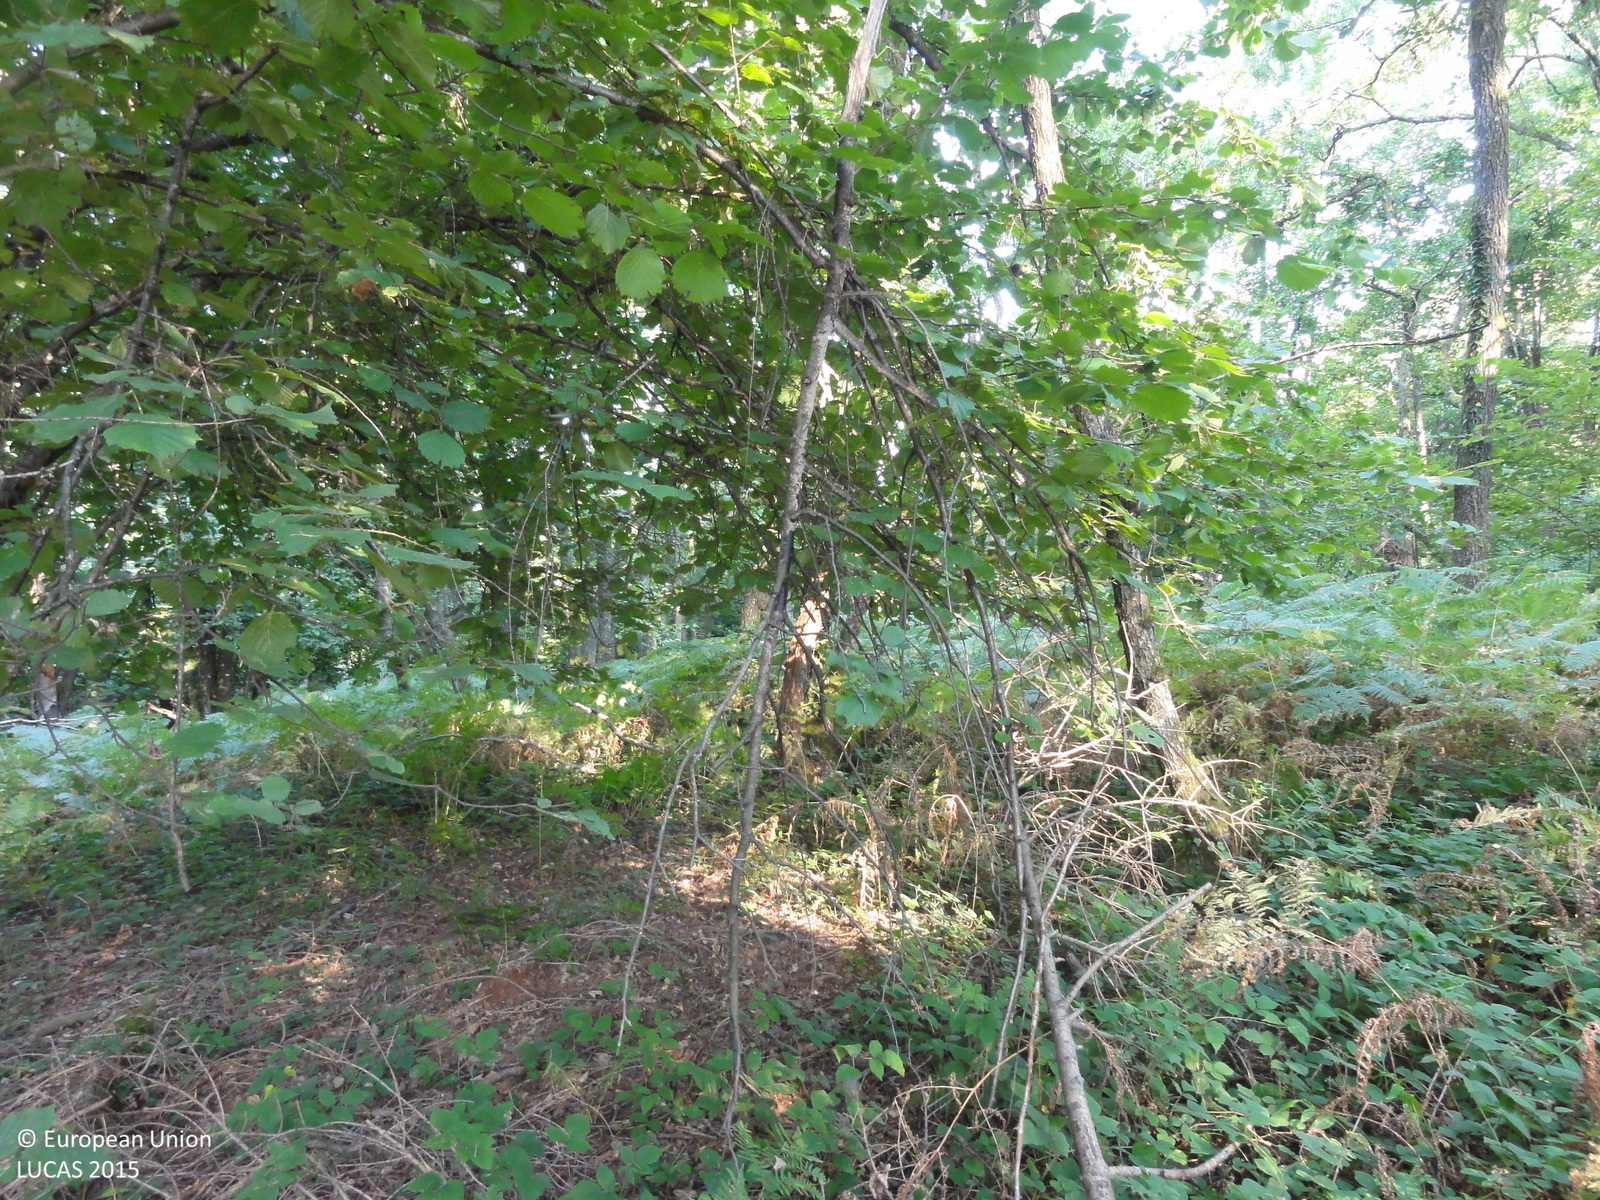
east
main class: Woodland
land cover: Spruce dominated mixed woodland
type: mesophytic deciduous forest
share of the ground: > 75 %
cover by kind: broadleaved forest trees 60 %, coniferous forest trees 40 %
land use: Forestry
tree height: > 5 m
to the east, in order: Spruce dominated mixed woodland; Broadleaved woodland
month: August
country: SI
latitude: 45.8179
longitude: 15.0287
